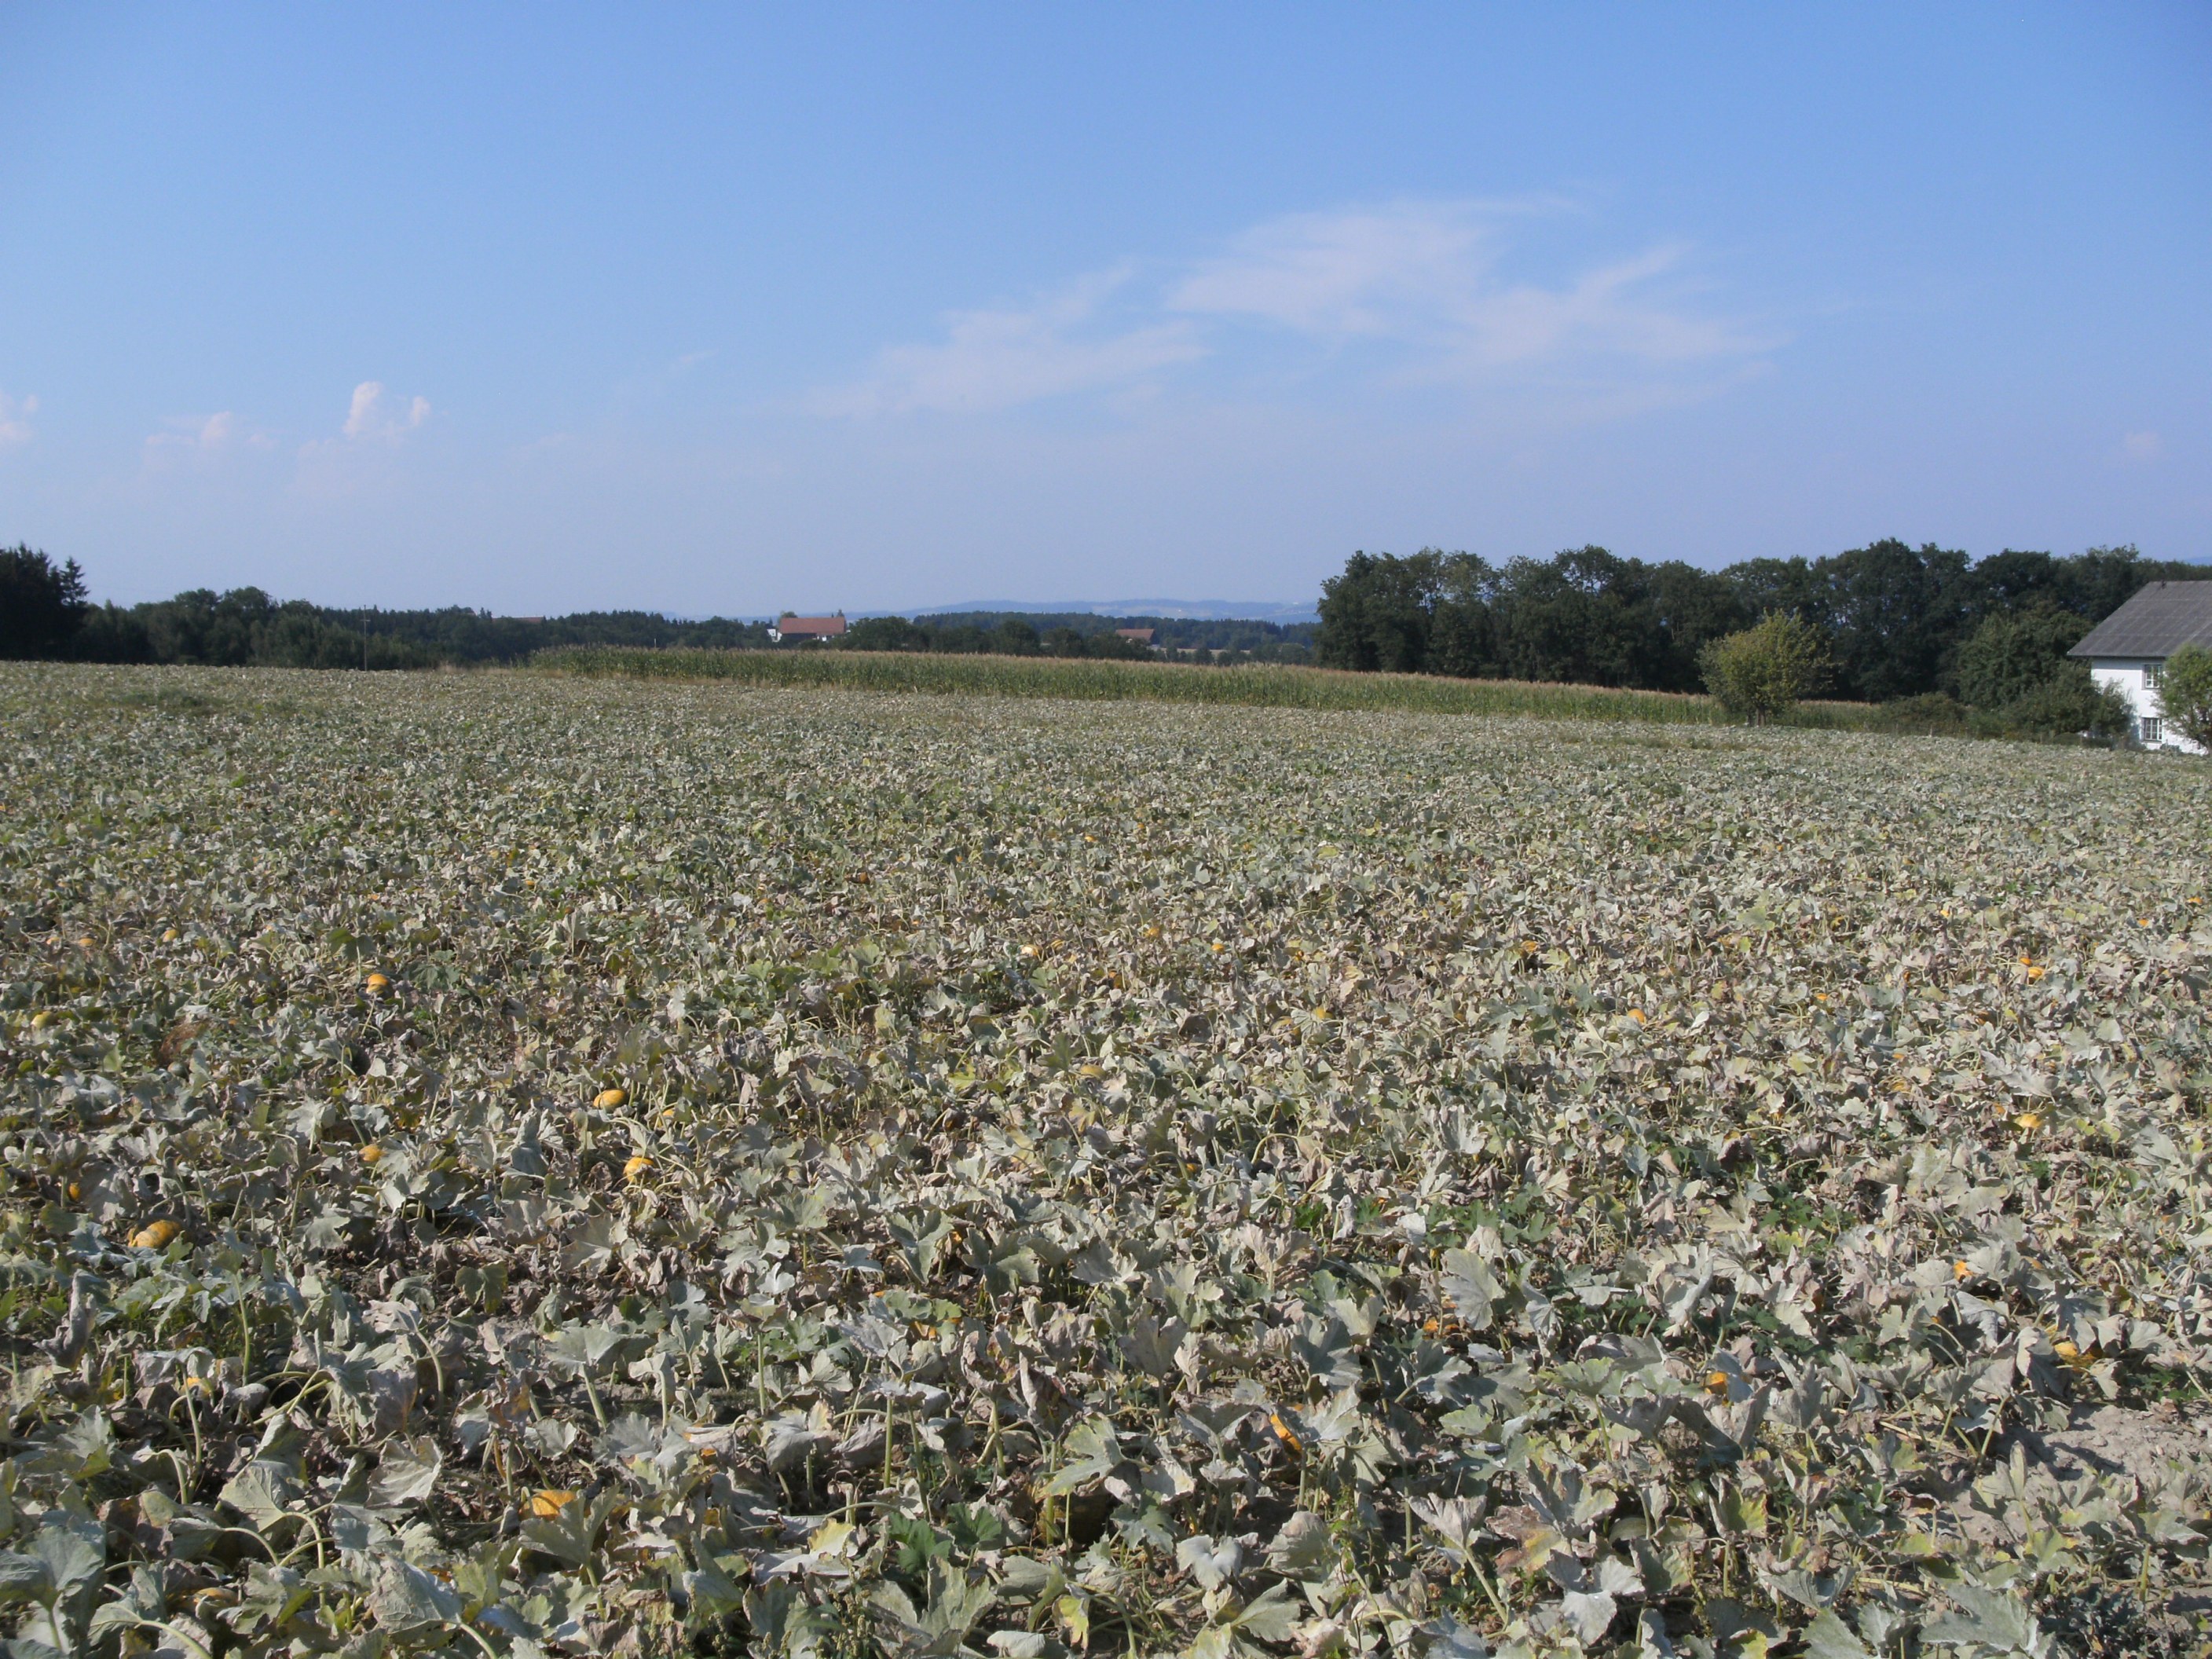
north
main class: Cropland
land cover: Other fresh vegetables
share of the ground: > 75 %
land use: Agriculture (excluding fallow land and kitchen gardens)
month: August
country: AT
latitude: 48.3475
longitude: 13.5212
